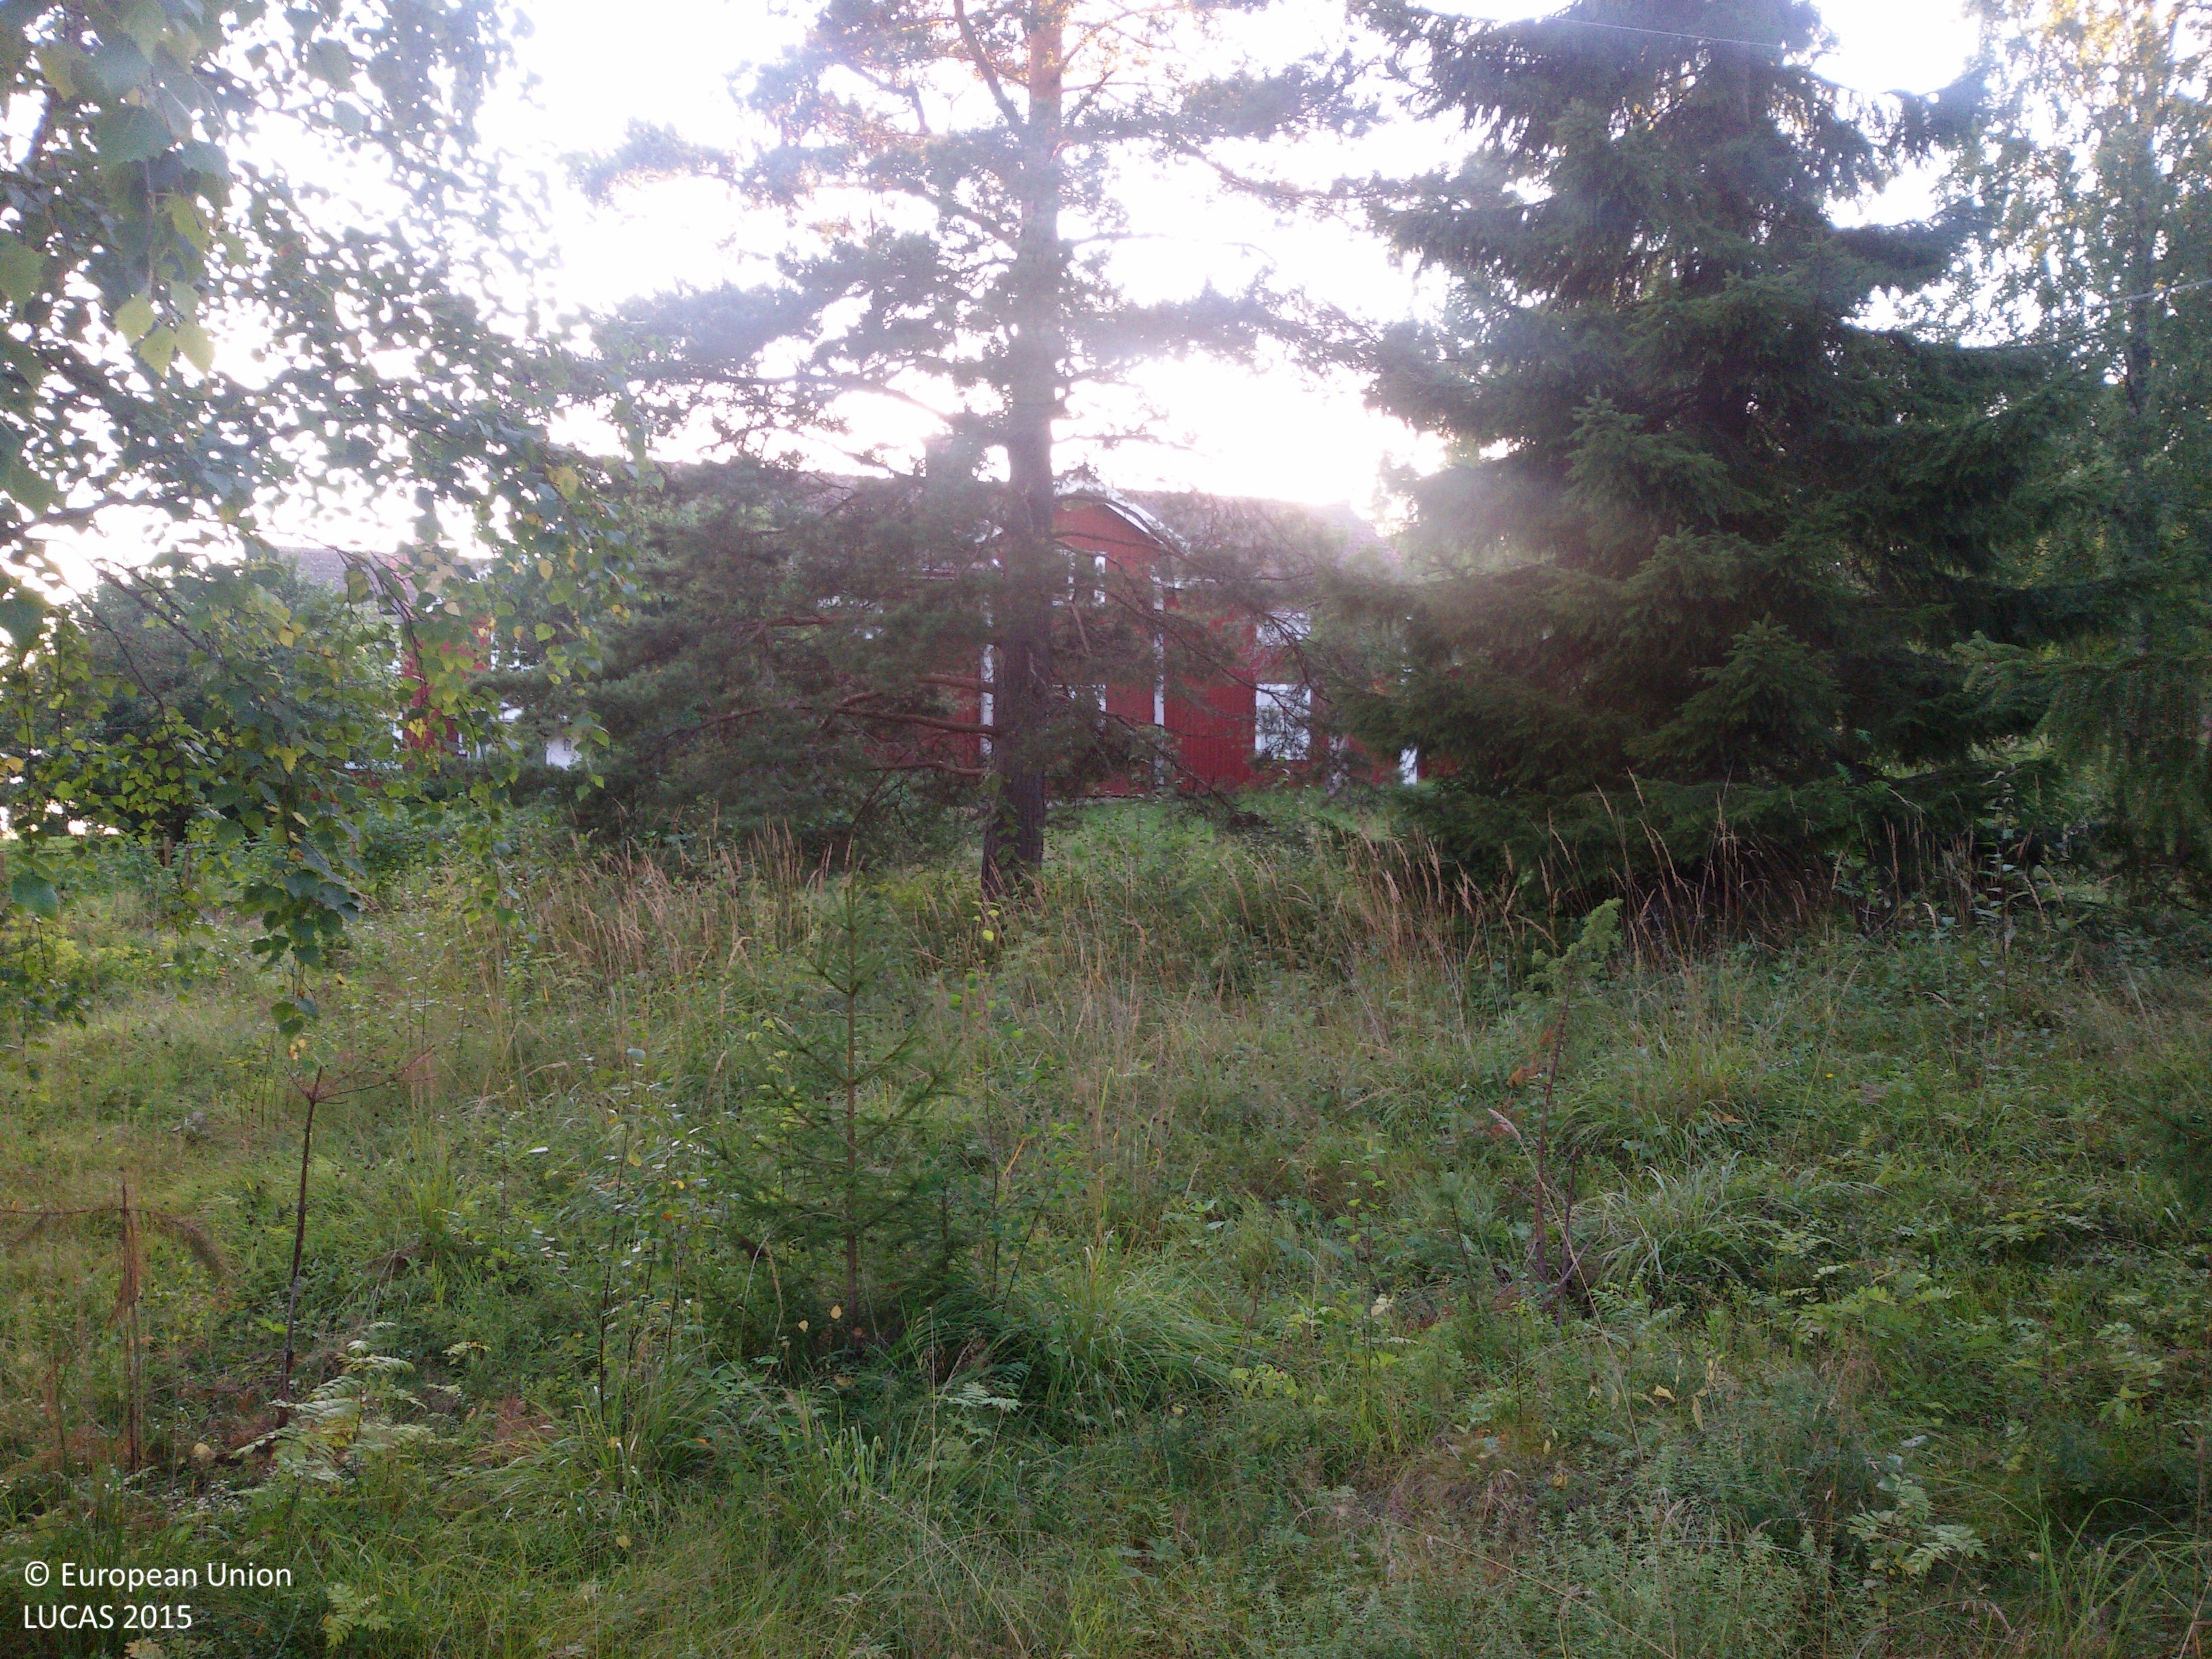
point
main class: Grassland
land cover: Grassland without tree/shrub cover
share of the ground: > 75 %
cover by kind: herbaceous plants 100 %
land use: Residential
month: September
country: SE
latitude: 60.9021
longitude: 15.0558
